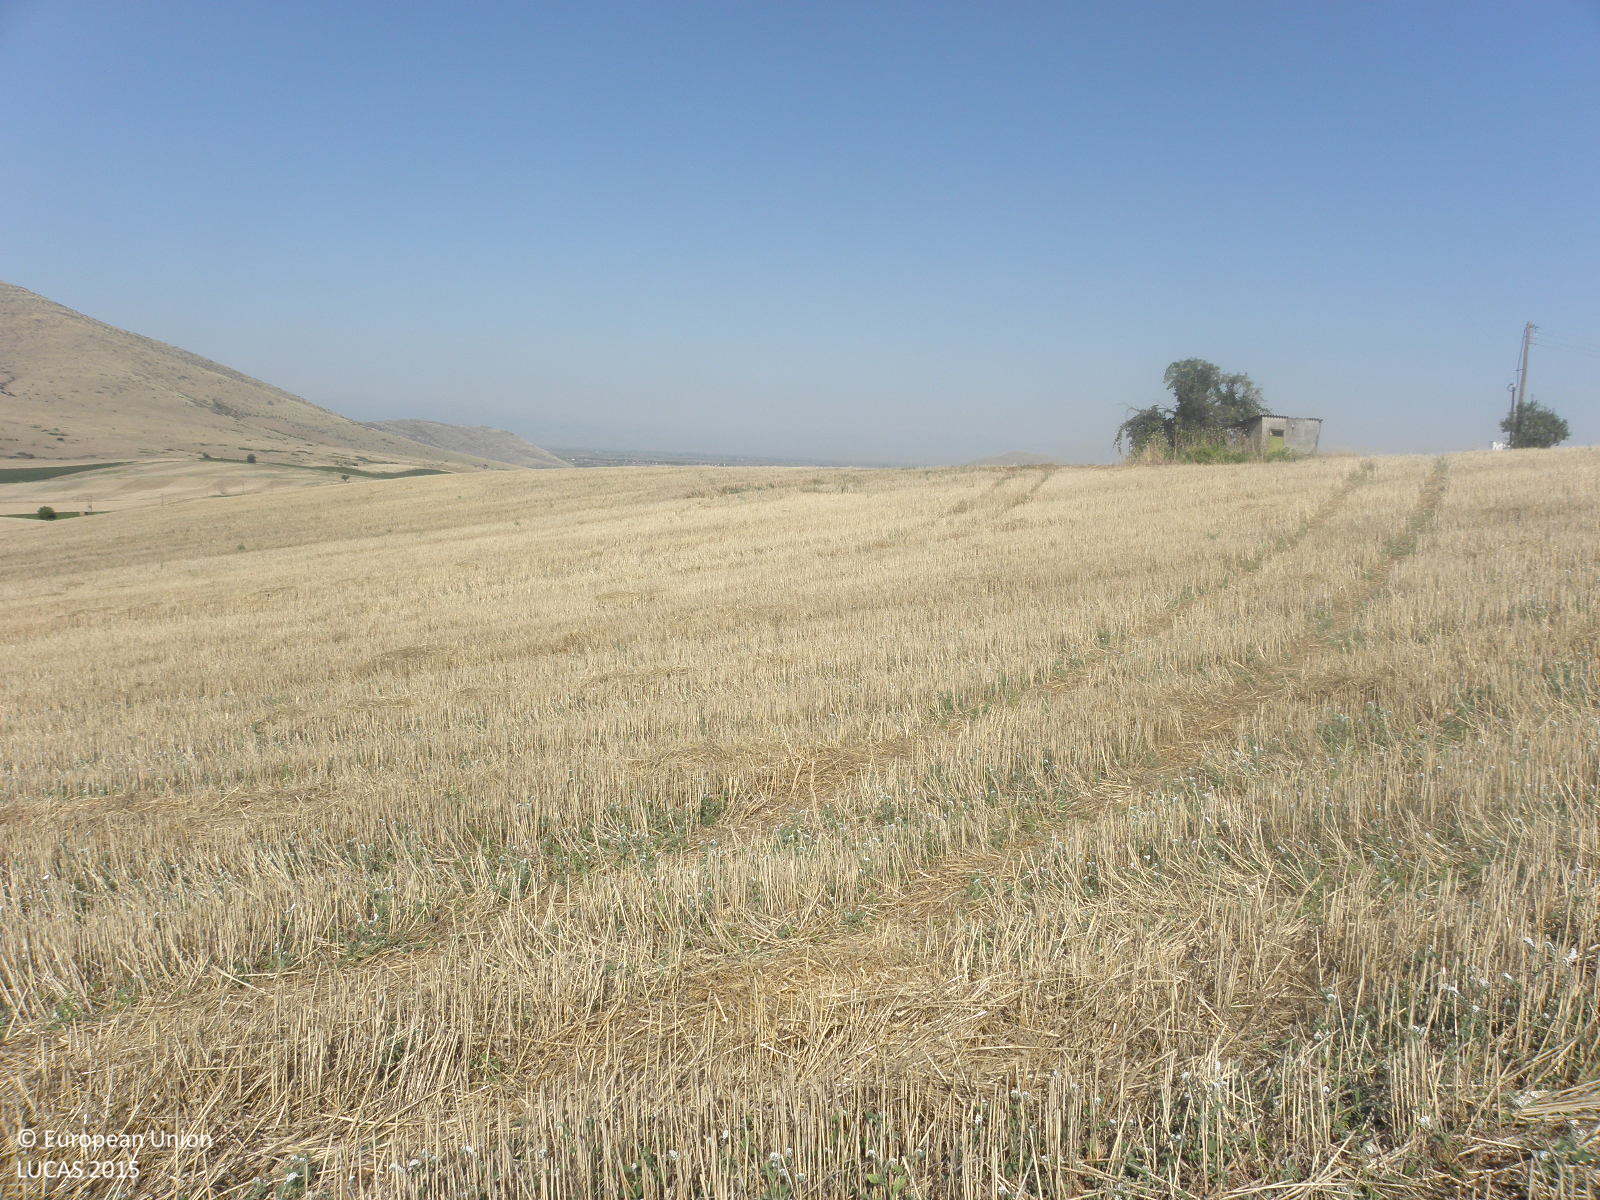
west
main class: Cropland
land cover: Durum wheat
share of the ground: > 75 %
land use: Agriculture (excluding fallow land and kitchen gardens)
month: July
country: GR
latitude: 39.4366
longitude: 22.2901
